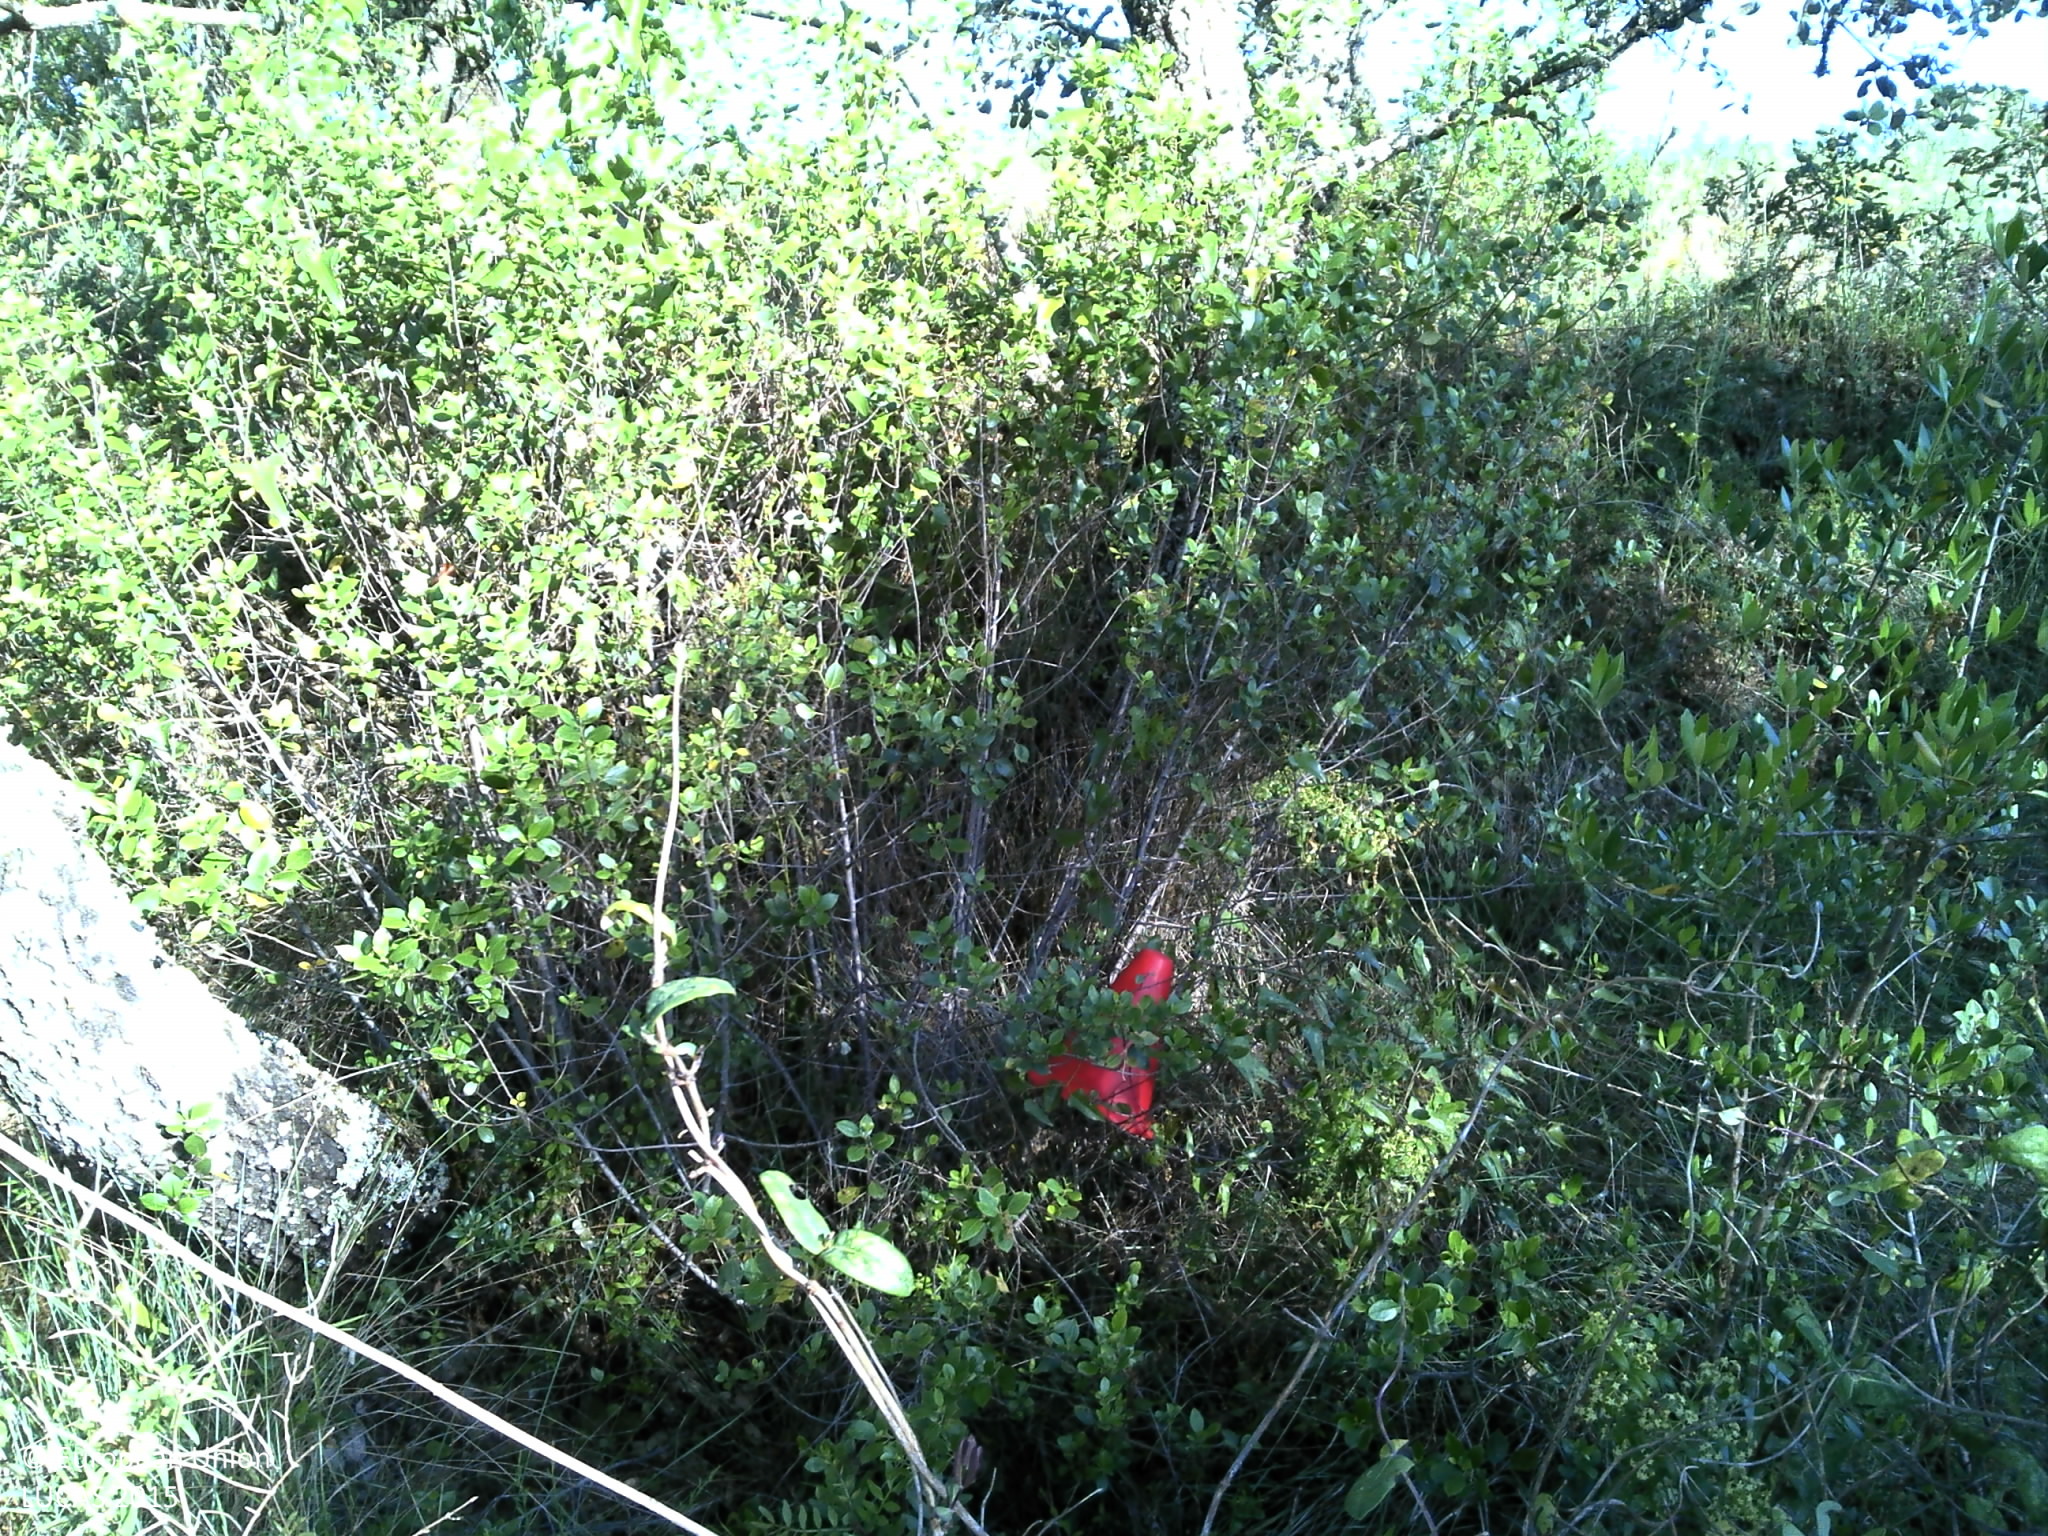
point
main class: Woodland
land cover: Broadleaved woodland
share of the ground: 25 - 50 %
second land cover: Shrubland without tree cover
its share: 25 - 50 %
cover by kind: broadleaved forest trees 50 %, shrubs 20 %, herbaceous plants 20 %, coniferous forest trees 10 %
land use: Forestry
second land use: Fallow land
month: May
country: PT
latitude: 39.6033
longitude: -8.4867
